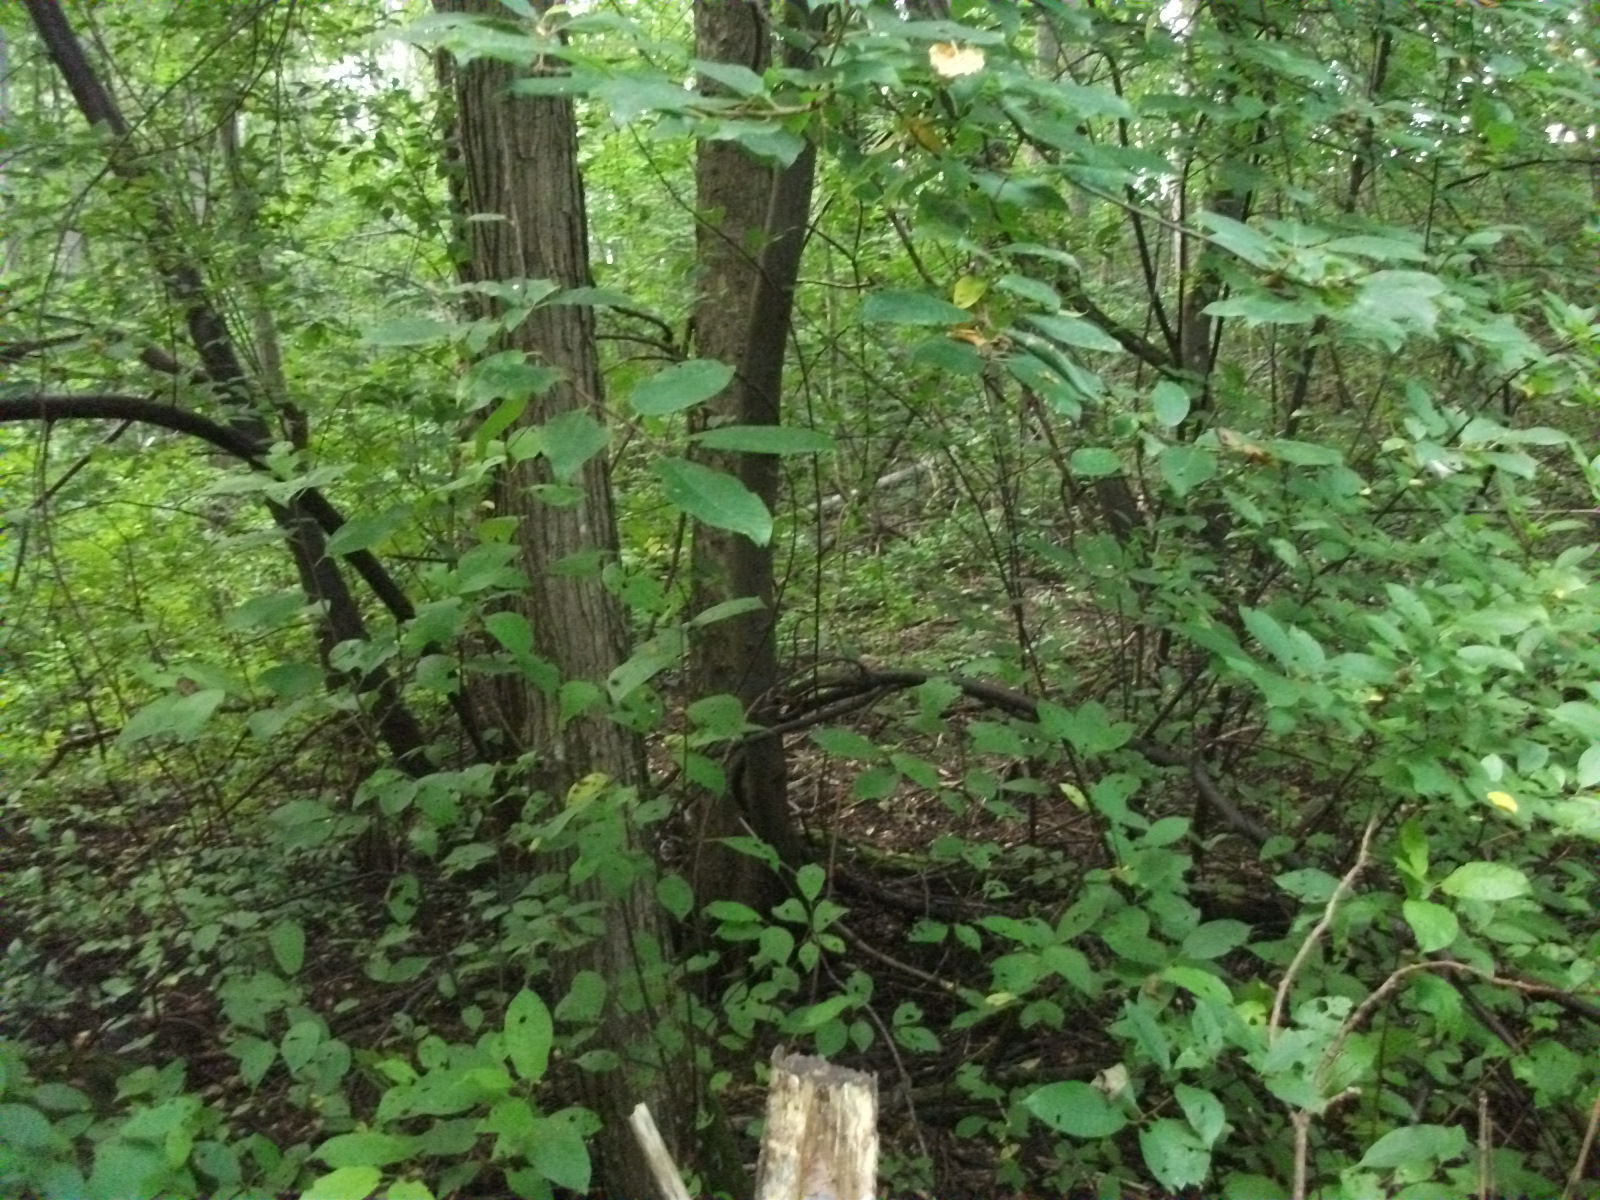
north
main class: Woodland
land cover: Broadleaved woodland
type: non-riverine alder, birch or aspen forest
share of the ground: > 75 %
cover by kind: broadleaved forest trees 85 %, shrubs 10 %, herbaceous plants 5 %
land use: Forestry
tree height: > 5 m
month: August
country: LV
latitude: 56.7579
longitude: 26.5538
